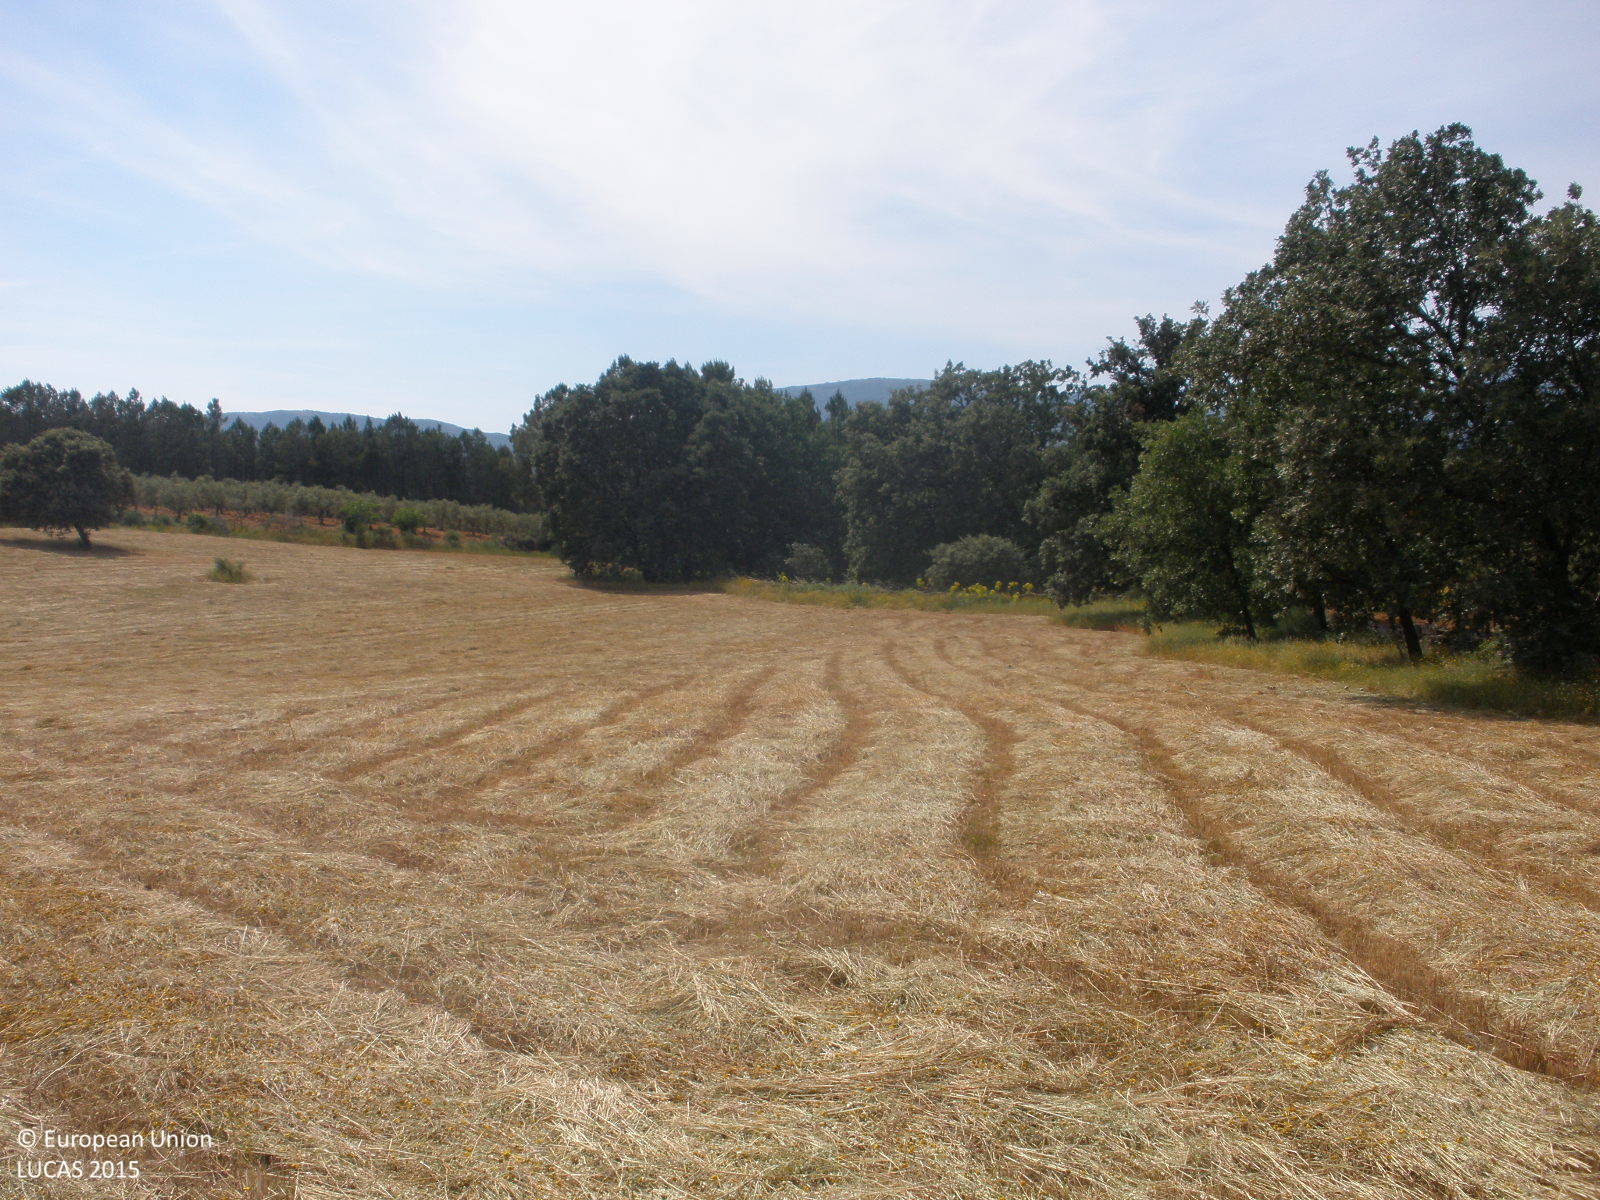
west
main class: Cropland
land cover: Oats
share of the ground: > 75 %
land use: Agriculture (excluding fallow land and kitchen gardens)
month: May
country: ES
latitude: 40.1636
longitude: -6.6284
